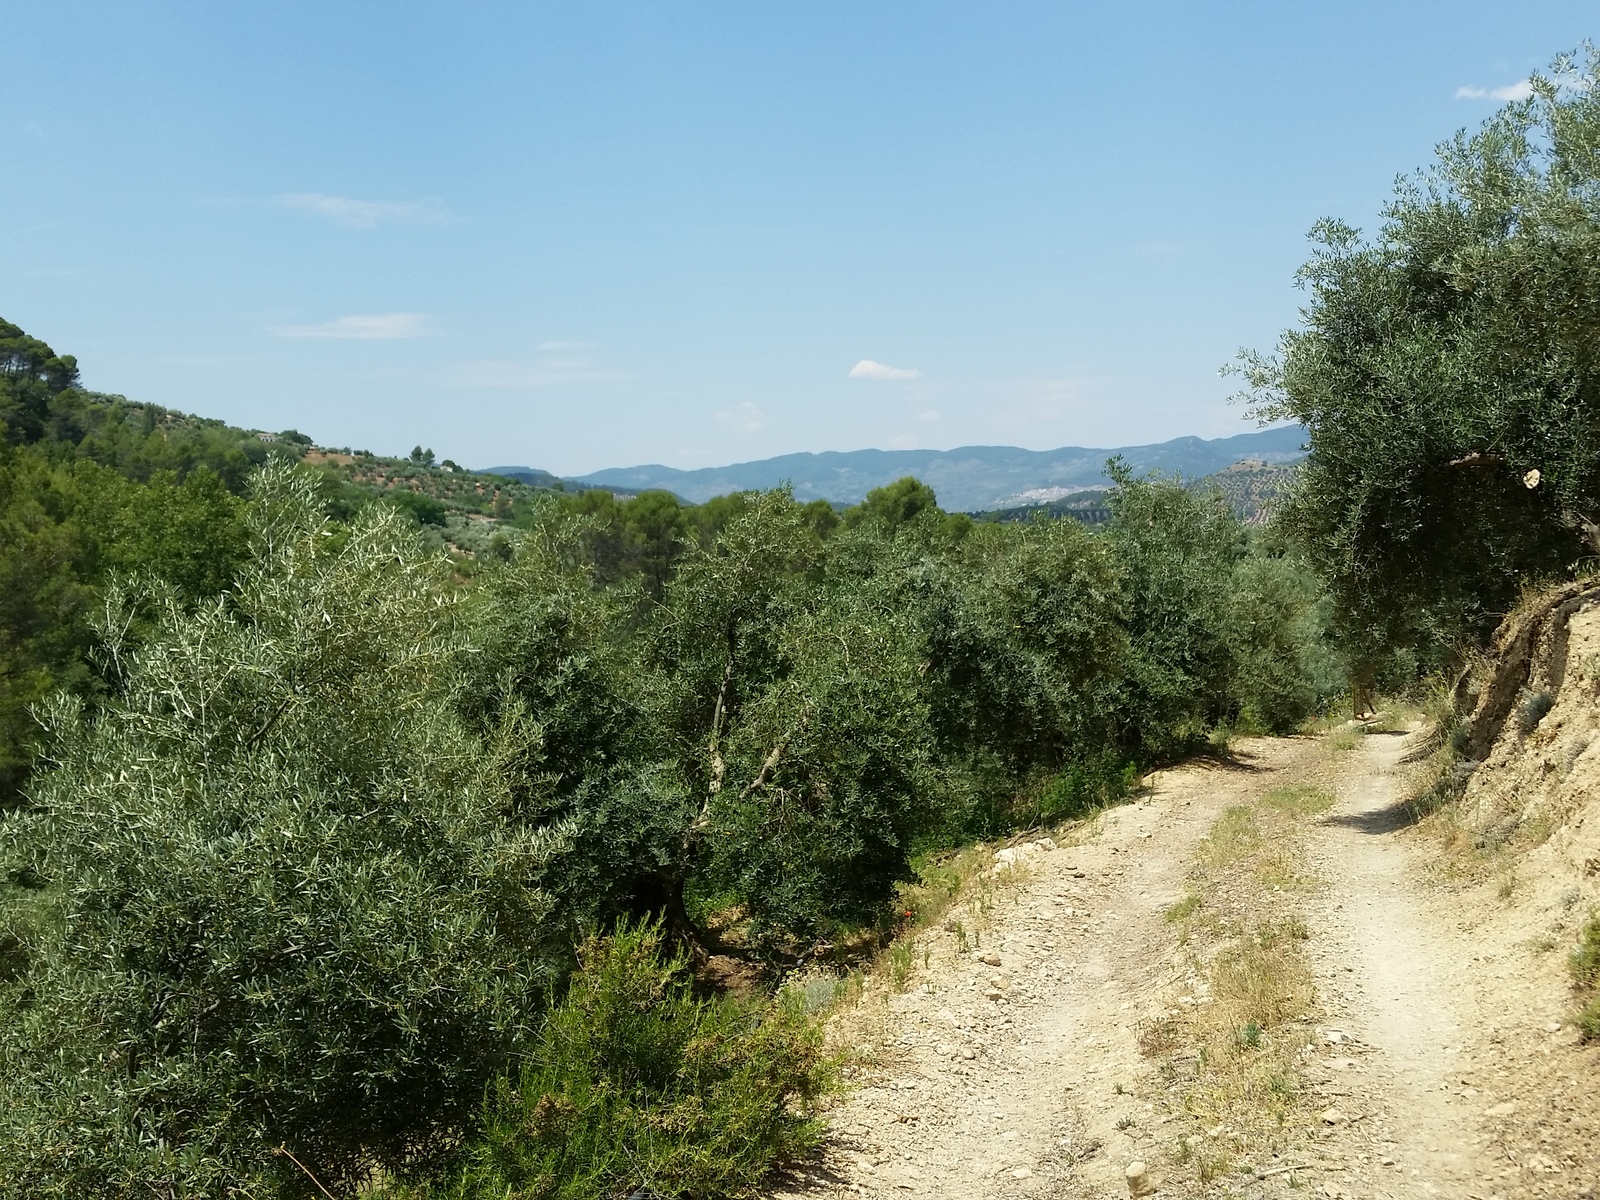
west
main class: Cropland
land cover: Olive groves
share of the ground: 50 - 75 %
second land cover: Other bare soil
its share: > 75 %
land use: Agriculture (excluding fallow land and kitchen gardens)
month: June
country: ES
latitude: 38.3747
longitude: -2.5777
